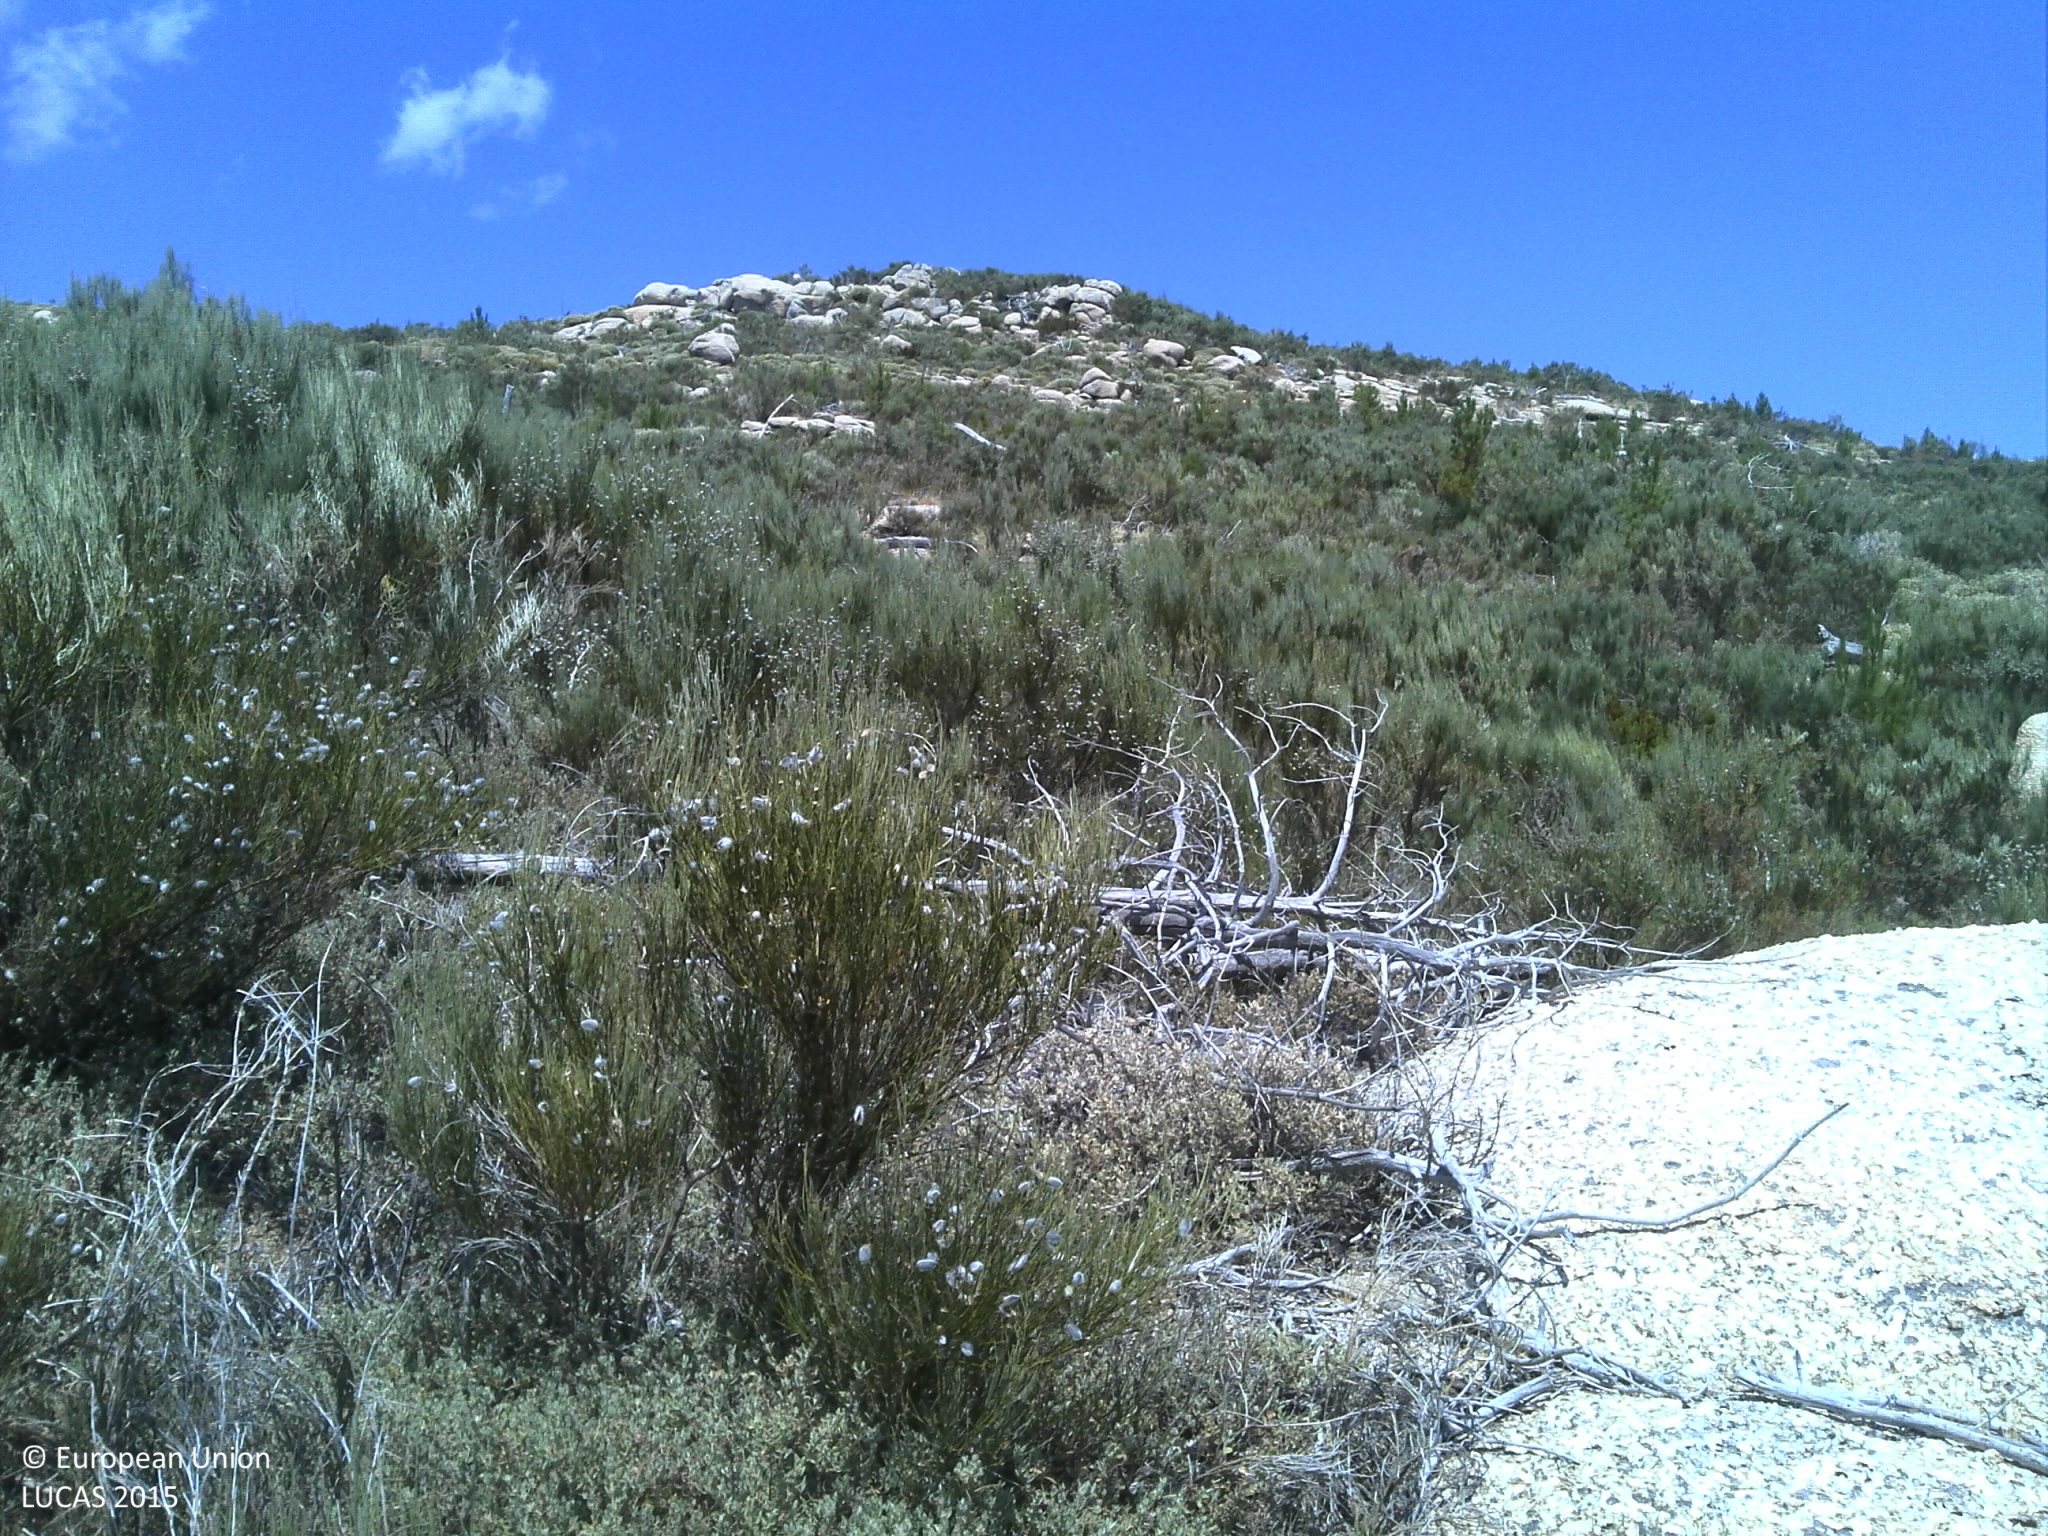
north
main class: Shrubland
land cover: Shrubland without tree cover
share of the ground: > 75 %
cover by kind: shrubs 75 %, consolidated bare surface 20 %, herbaceous plants 5 %
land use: Semi-natural and natural areas not in use
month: July
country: PT
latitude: 40.3559
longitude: -7.5238
